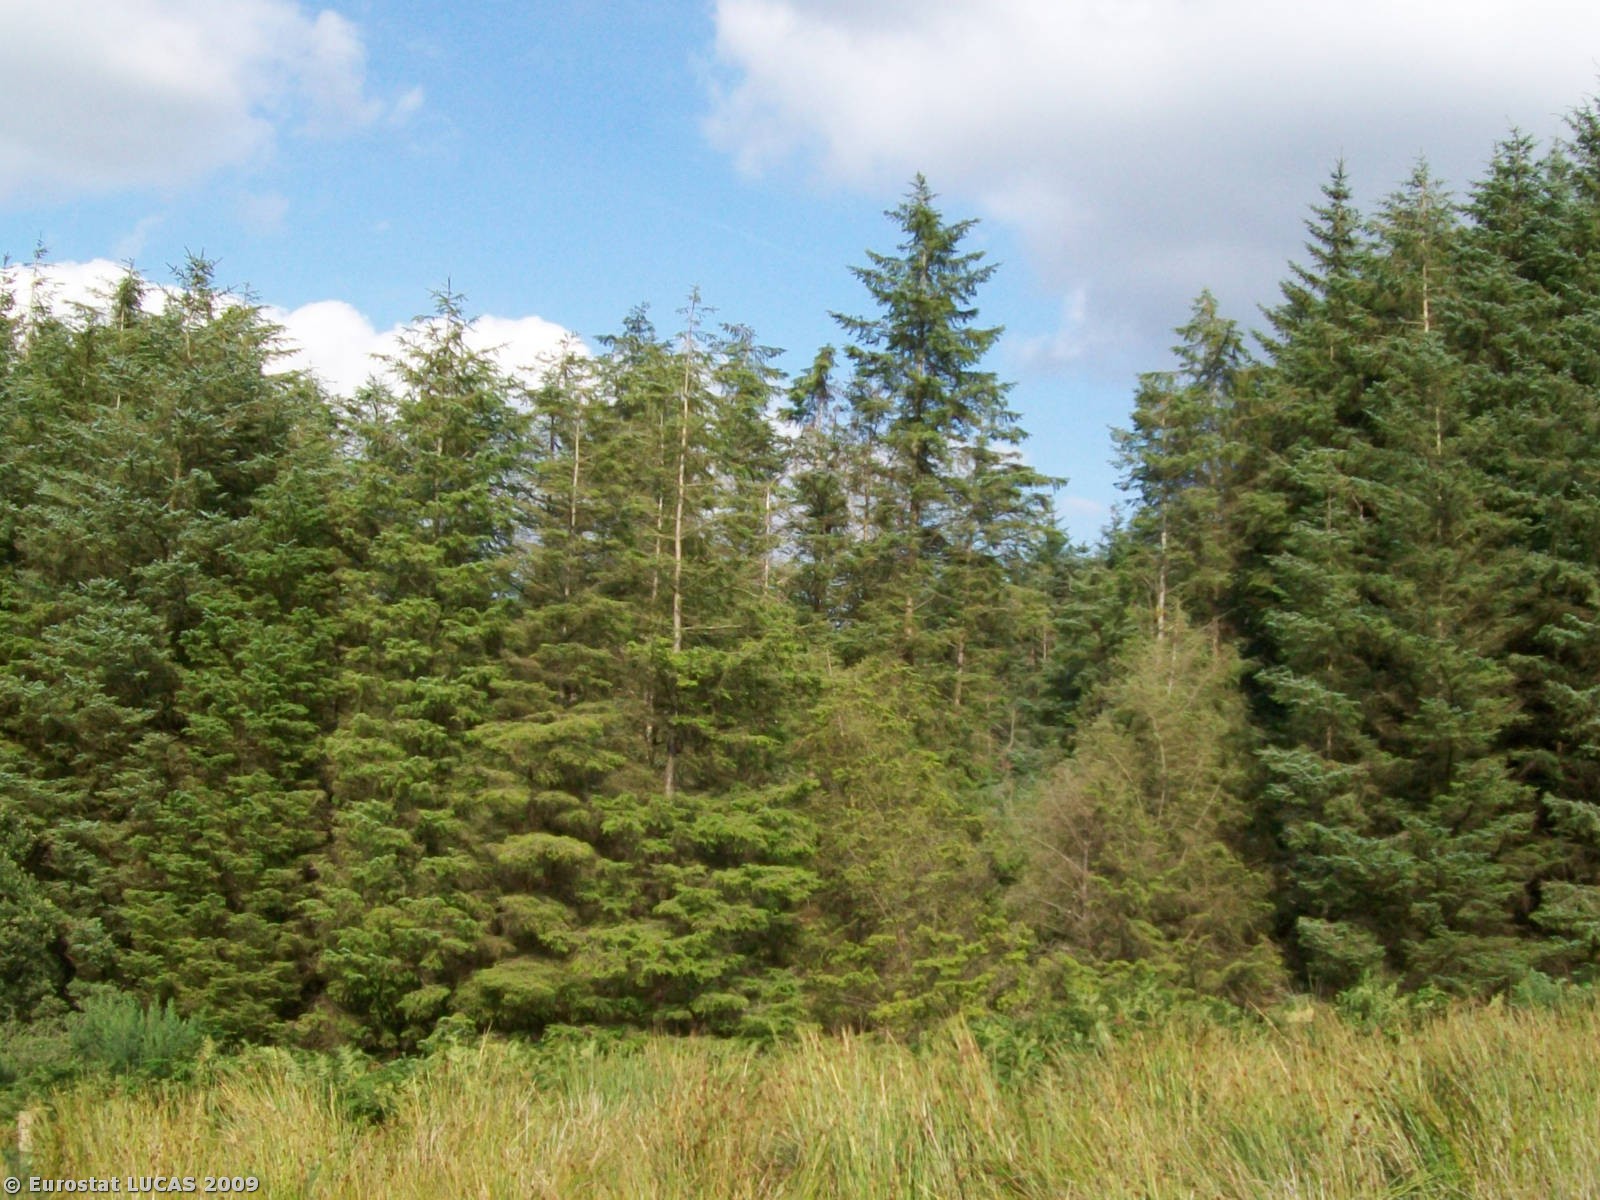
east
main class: Woodland
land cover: Coniferous woodland
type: plantations and self-sown exotic forest
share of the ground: > 75 %
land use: Forestry
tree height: > 5 m
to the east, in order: Coniferous woodland; Grassland without tree/shrub cover
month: August
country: IE
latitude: 52.7899
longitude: -9.1861
